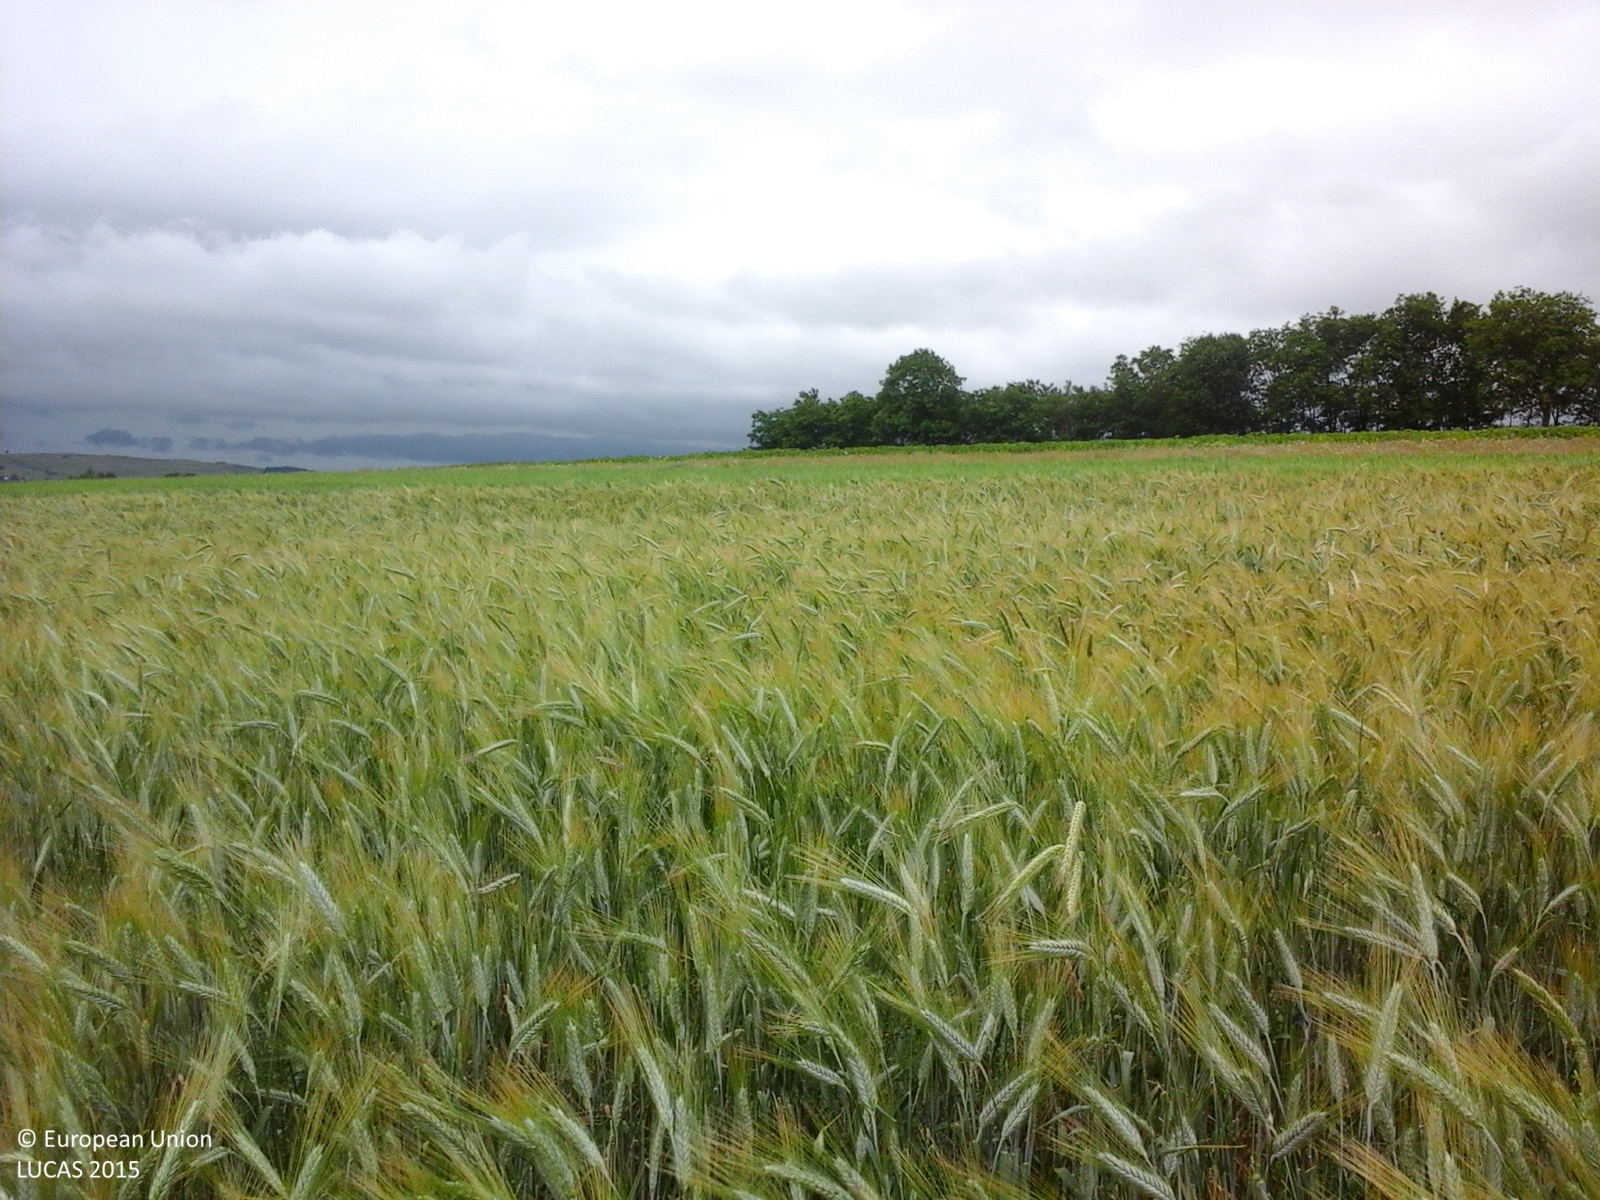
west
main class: Cropland
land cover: Lucerne
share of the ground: > 75 %
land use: Agriculture (excluding fallow land and kitchen gardens)
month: June
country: RO
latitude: 48.0856
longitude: 26.4009
